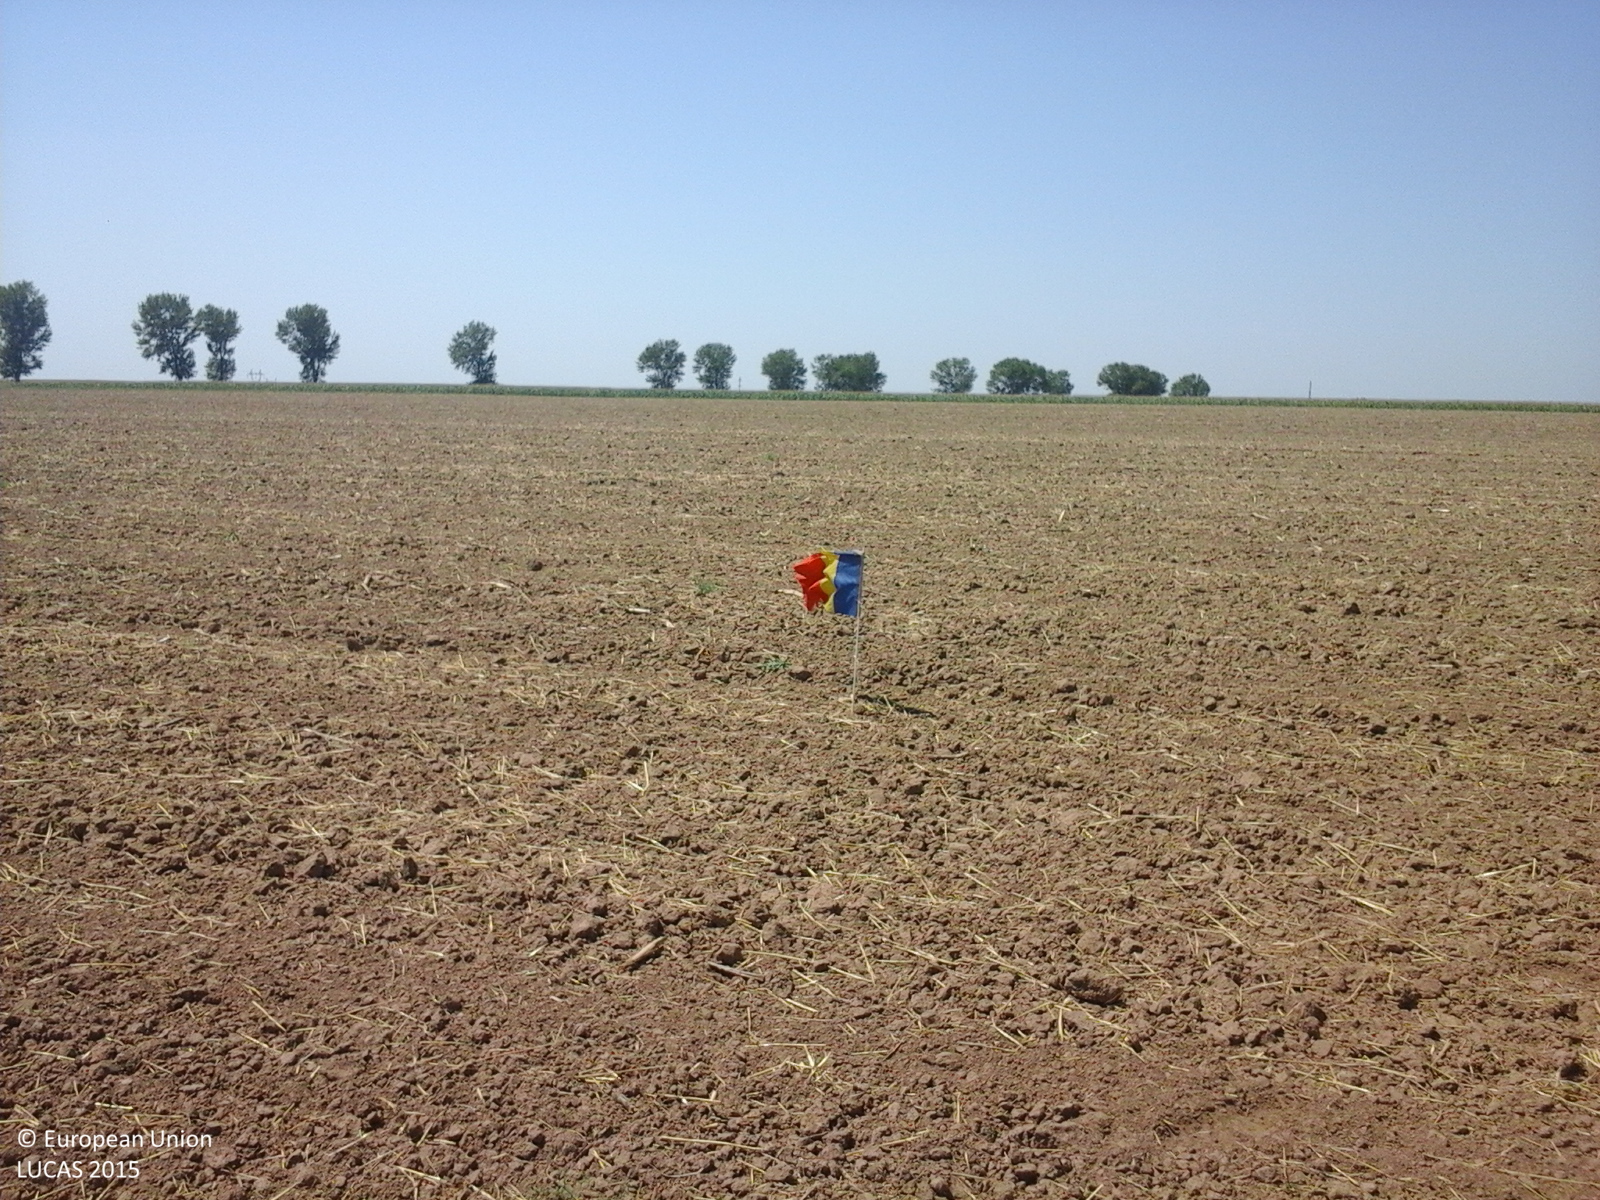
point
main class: Cropland
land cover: Common wheat
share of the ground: < 10 %
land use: Agriculture (excluding fallow land and kitchen gardens)
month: August
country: RO
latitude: 44.6333
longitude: 28.0484
